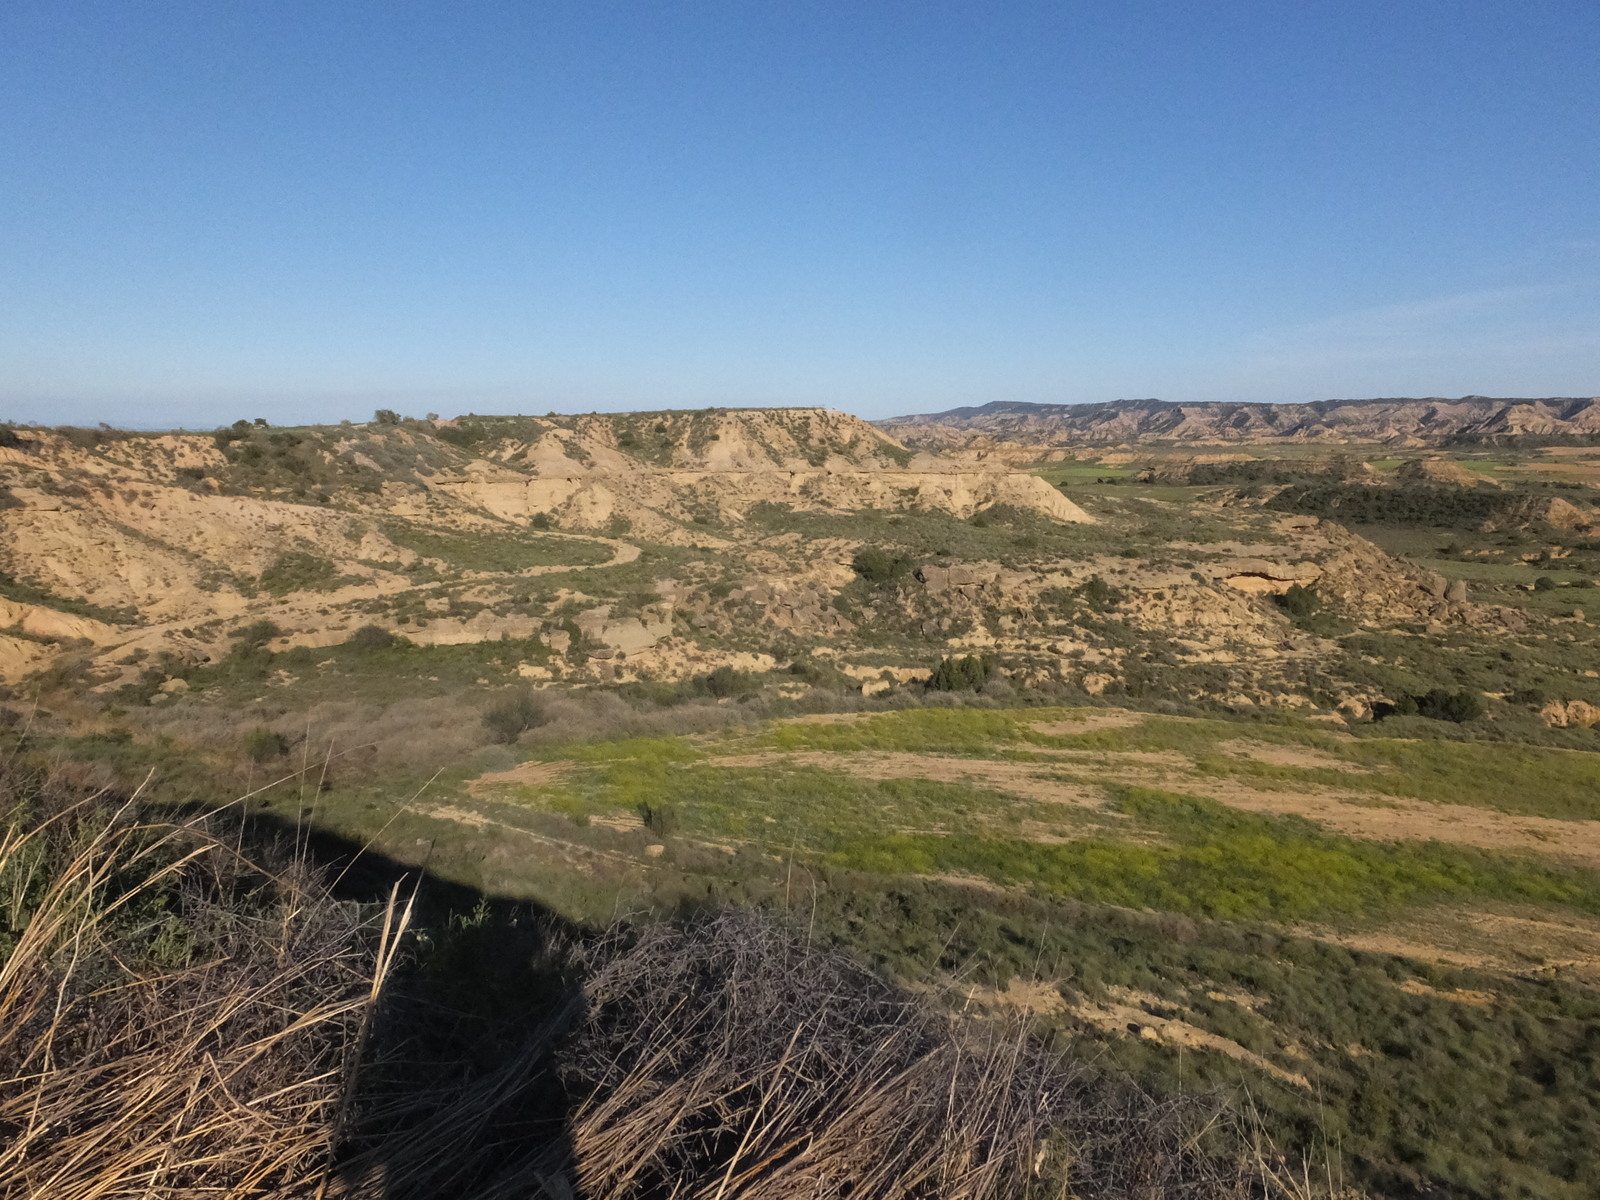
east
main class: Grassland
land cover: Grassland with sparse tree/shrub cover
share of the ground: > 75 %
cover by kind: herbaceous plants 90 %, coniferous forest trees 5 %, shrubs 5 %
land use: Semi-natural and natural areas not in use
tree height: < 5 m
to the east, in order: Grassland with sparse tree/shrub cover; Shrubland without tree cover; Tracks; Shruby margins; Other bare soil; Shrubland without tree cover; Rock outcrops; Shrubland without tree cover; Tracks; Shrubland without tree cover; Tracks; Shrubland without tree cover; Rock outcrops
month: April
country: ES
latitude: 41.7016
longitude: -0.1957
